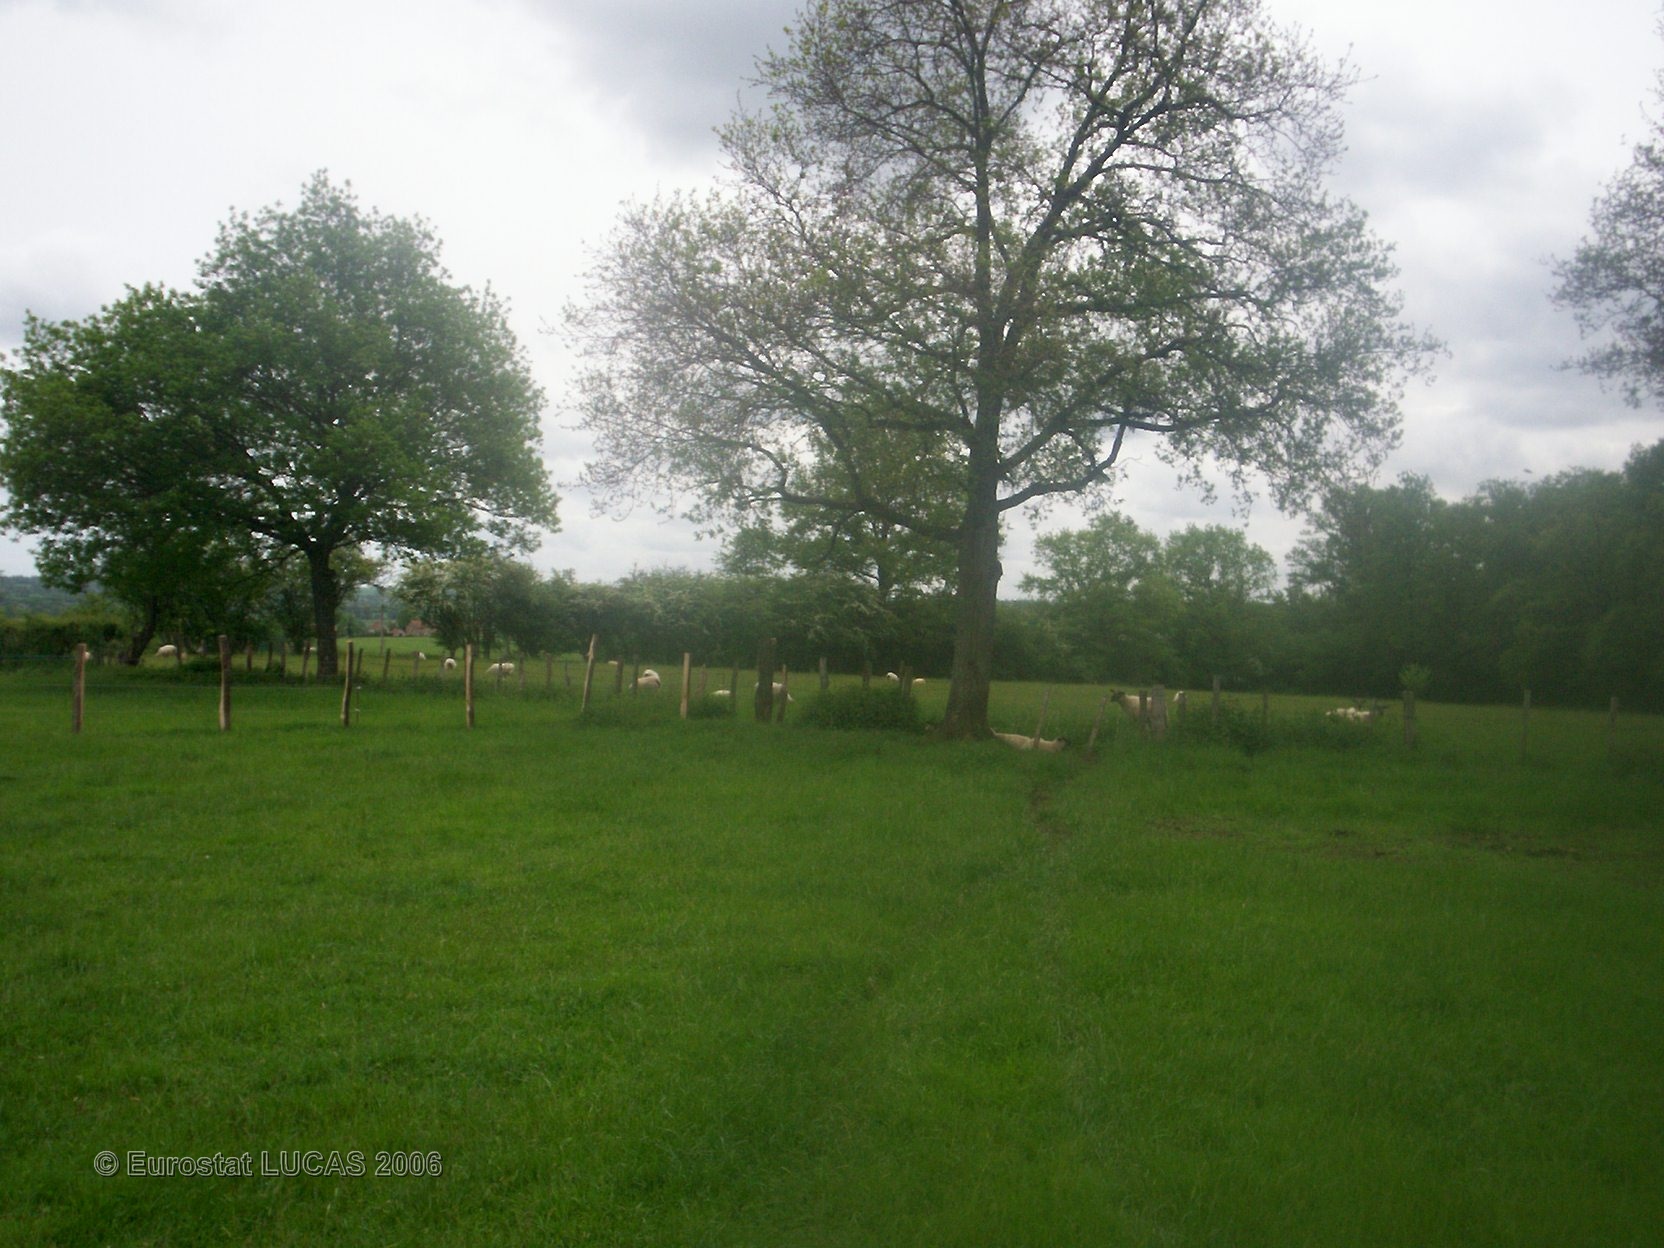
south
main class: Grassland
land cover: Grassland without tree/shrub cover
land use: Agriculture (excluding fallow land and kitchen gardens)
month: May
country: FR
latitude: 46.2044
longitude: 2.8824
